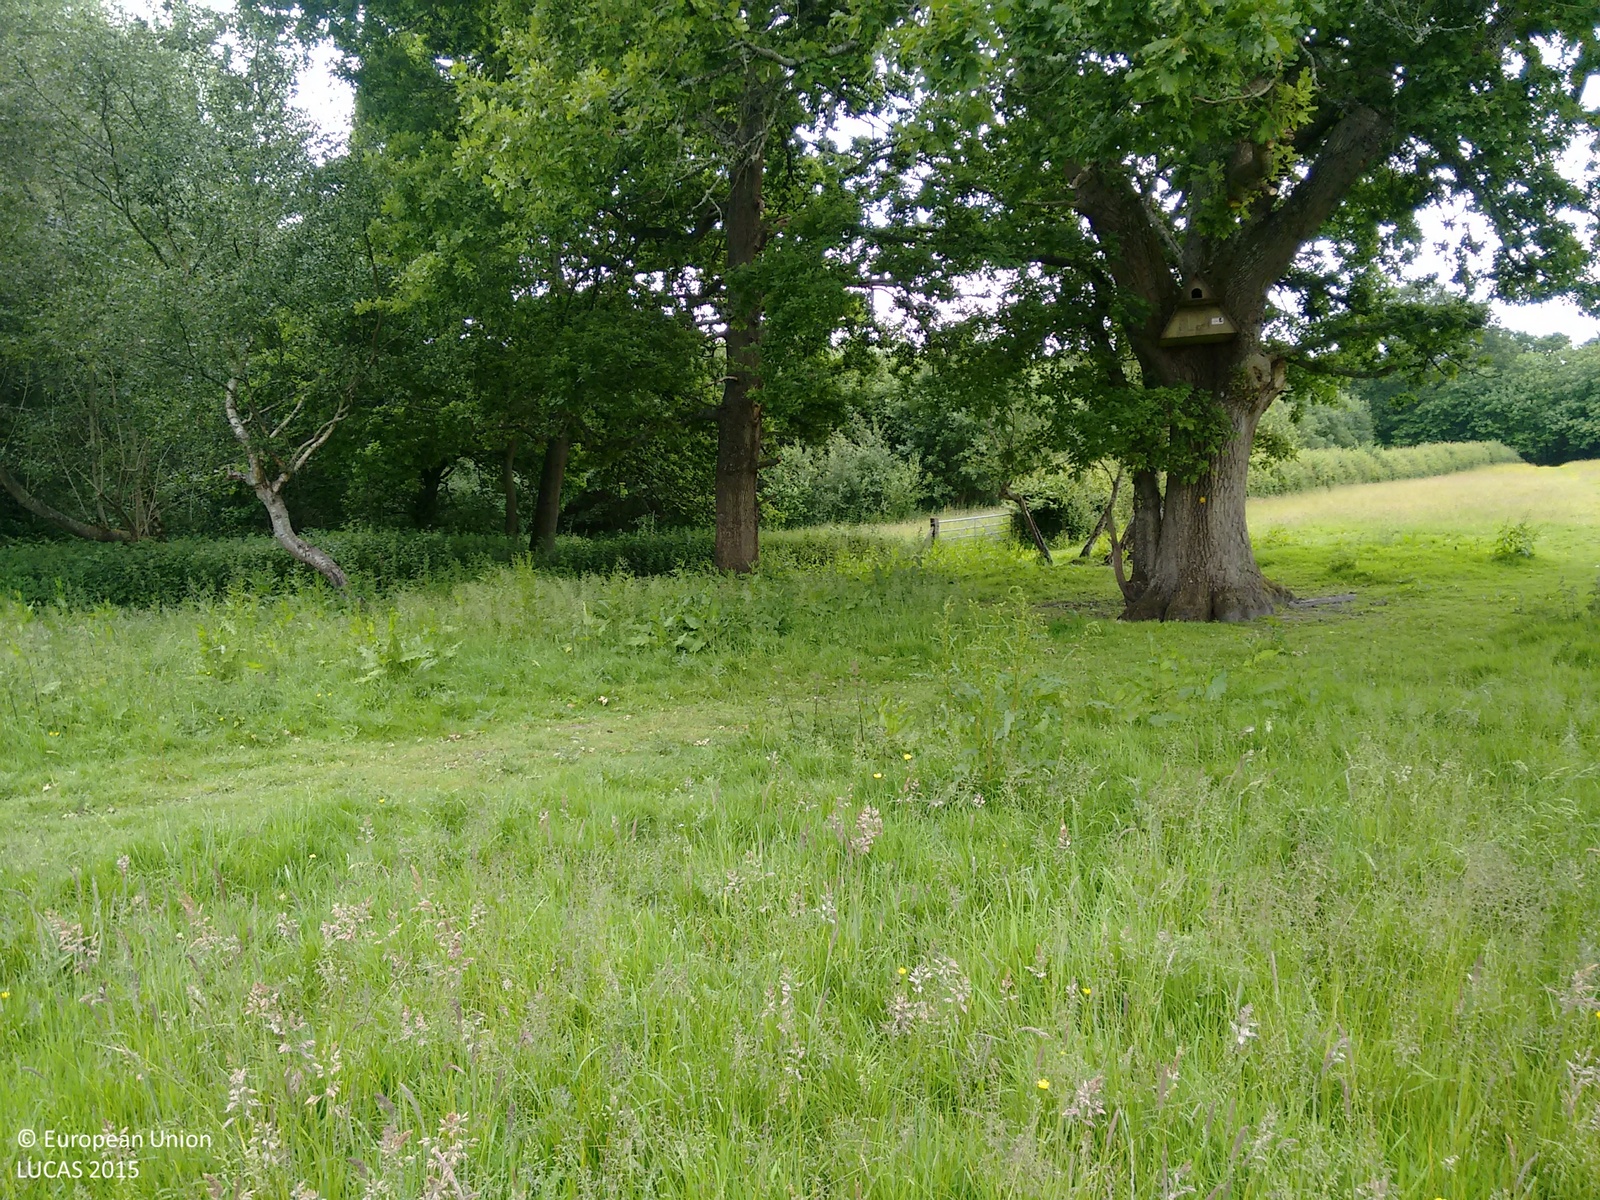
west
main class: Grassland
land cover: Grassland without tree/shrub cover
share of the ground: > 75 %
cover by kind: herbaceous plants 100 %
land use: Agriculture (excluding fallow land and kitchen gardens)
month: June
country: GB
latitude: 50.9558
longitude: 0.1889
